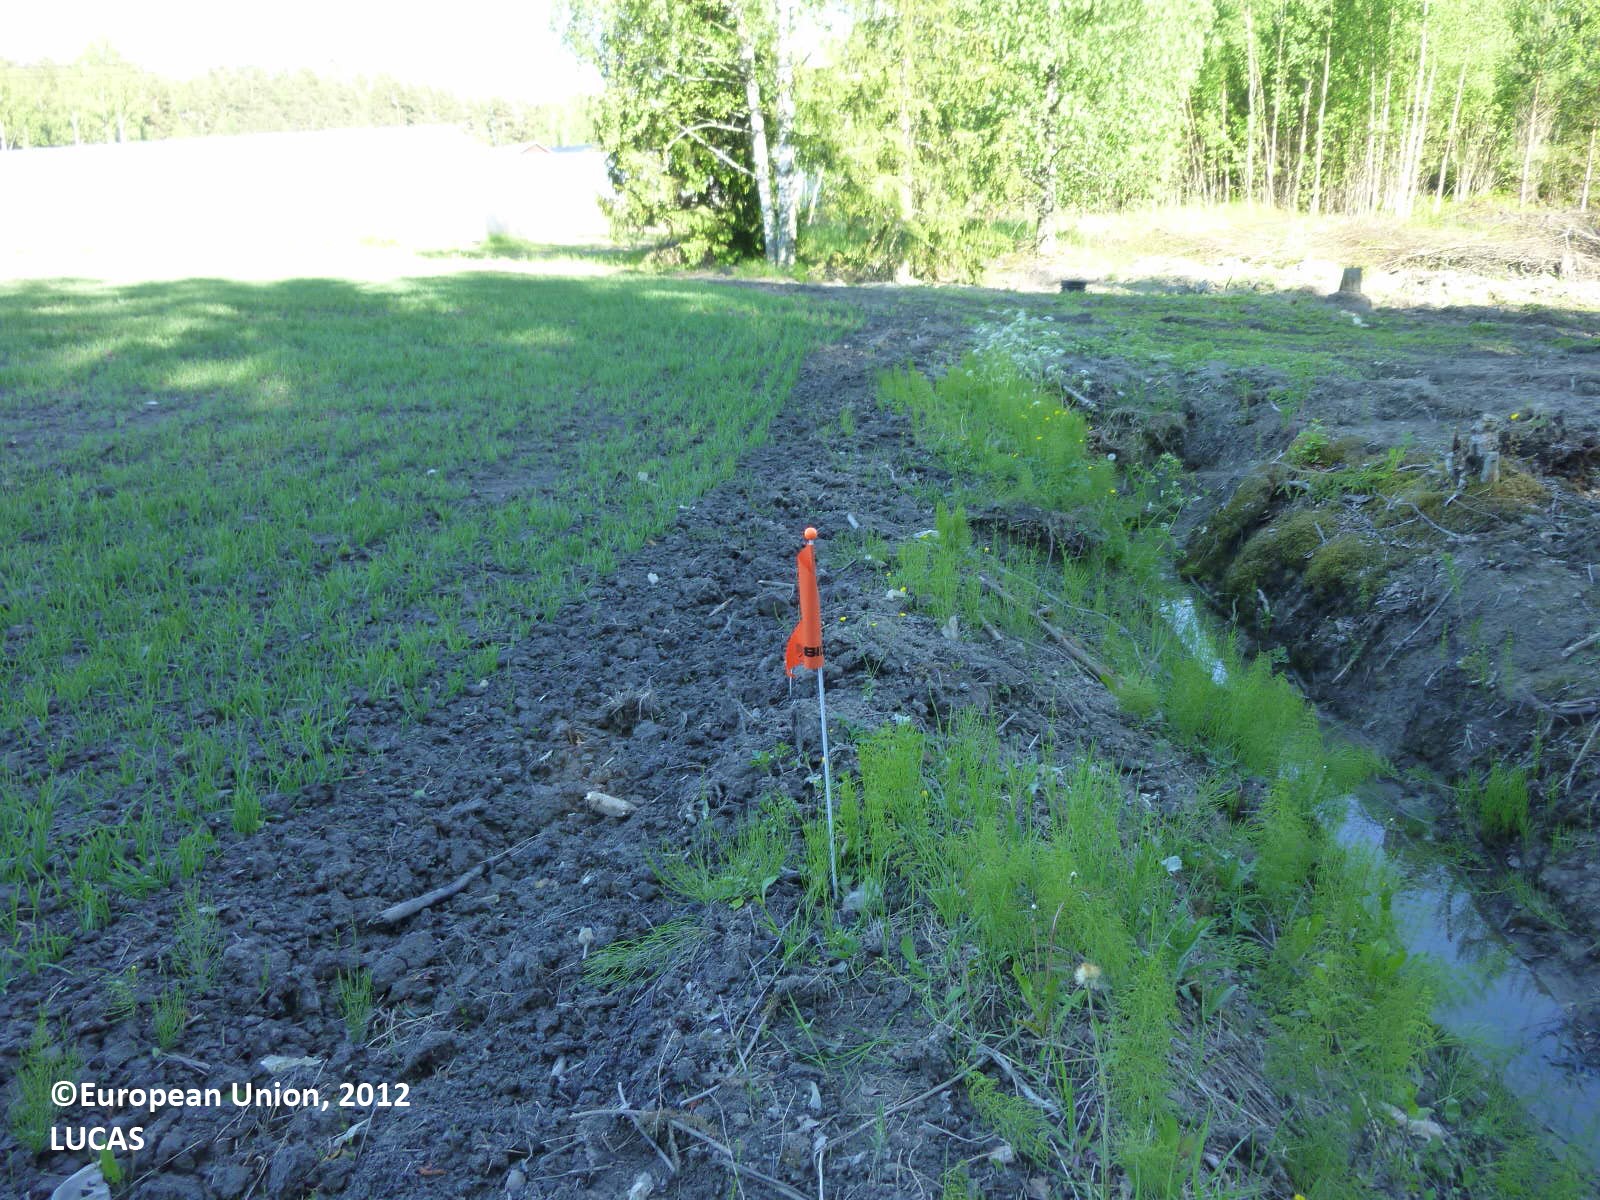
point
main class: Cropland
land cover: Common wheat
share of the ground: > 75 %
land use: Agriculture (excluding fallow land and kitchen gardens)
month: June
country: FI
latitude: 60.3377
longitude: 22.6637
